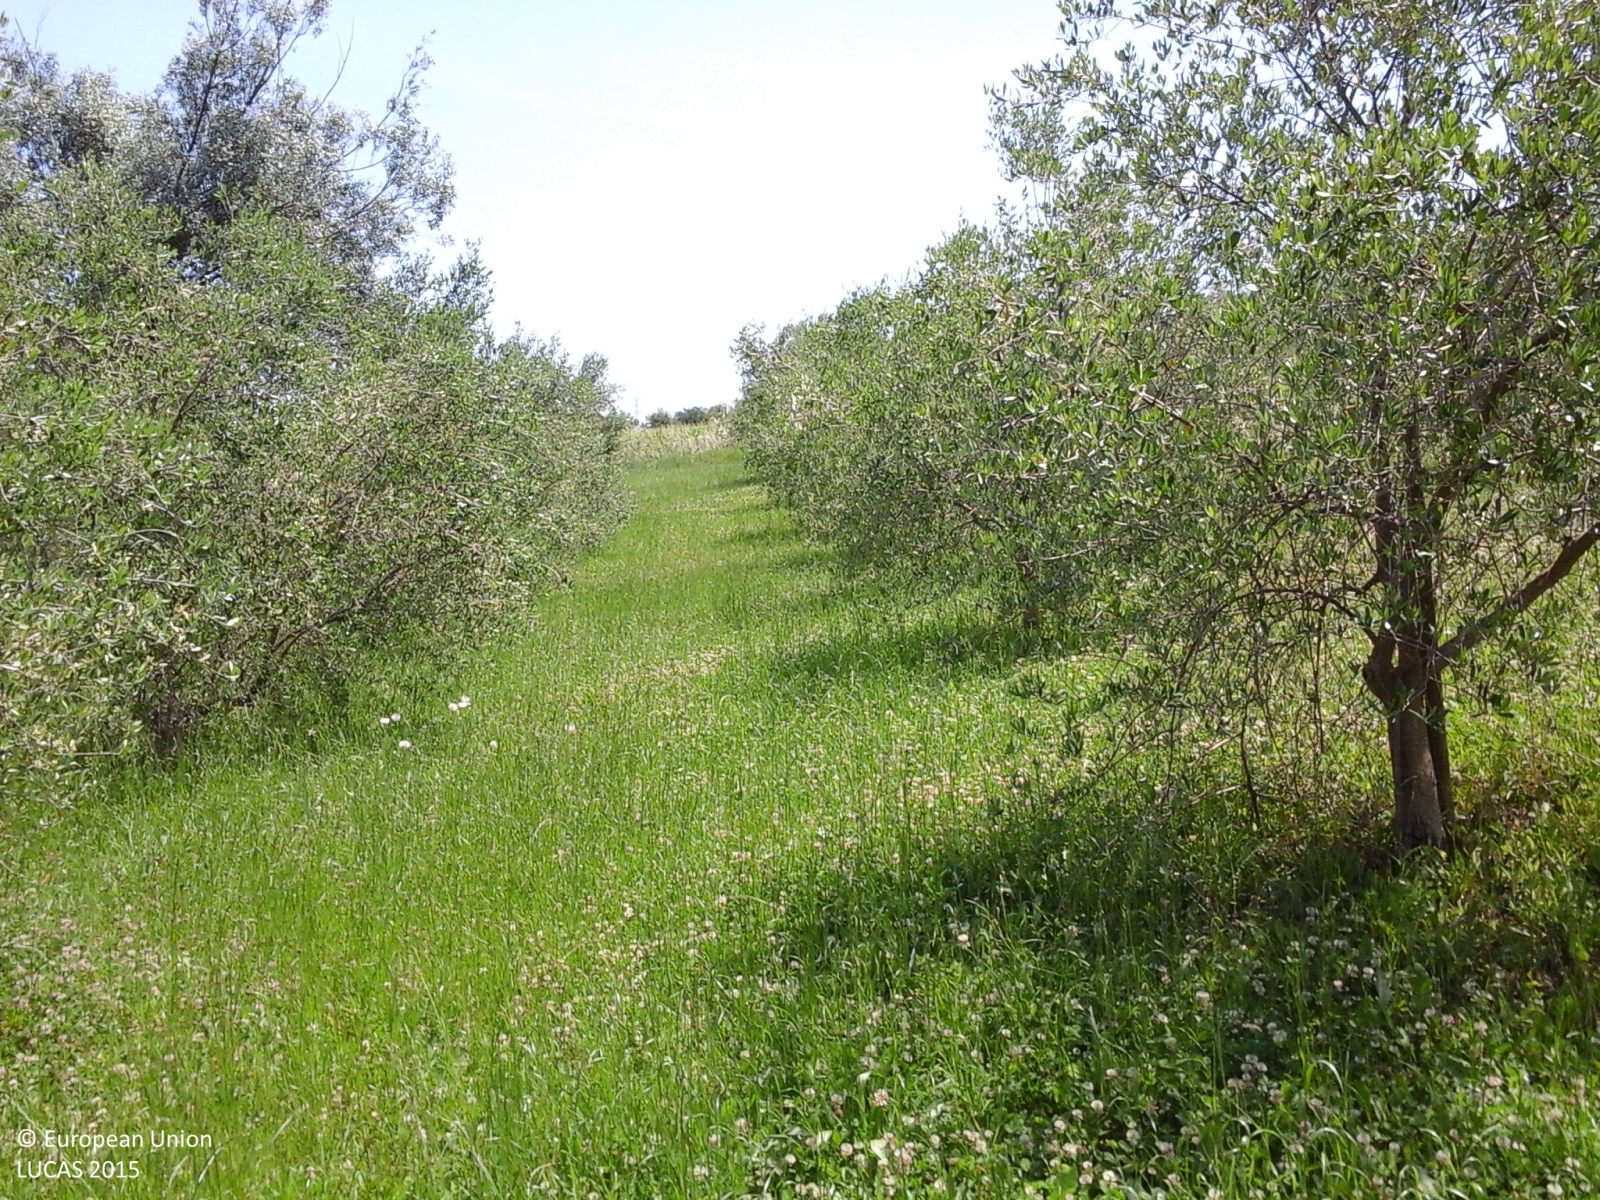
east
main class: Cropland
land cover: Olive groves
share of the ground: > 75 %
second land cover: Spontaneously vegetated surfaces
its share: > 75 %
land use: Agriculture (excluding fallow land and kitchen gardens)
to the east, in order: Olive groves; Spontaneously vegetated surfaces; Ditches and canals; Spontaneously vegetated surfaces; Other fruit trees and berries; Grass margins; Tracks; Grass margins; Vineyards; Tracks; Vineyards; Artificial constructions in urban areas
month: May
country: IT
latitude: 44.0515
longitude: 12.4283
